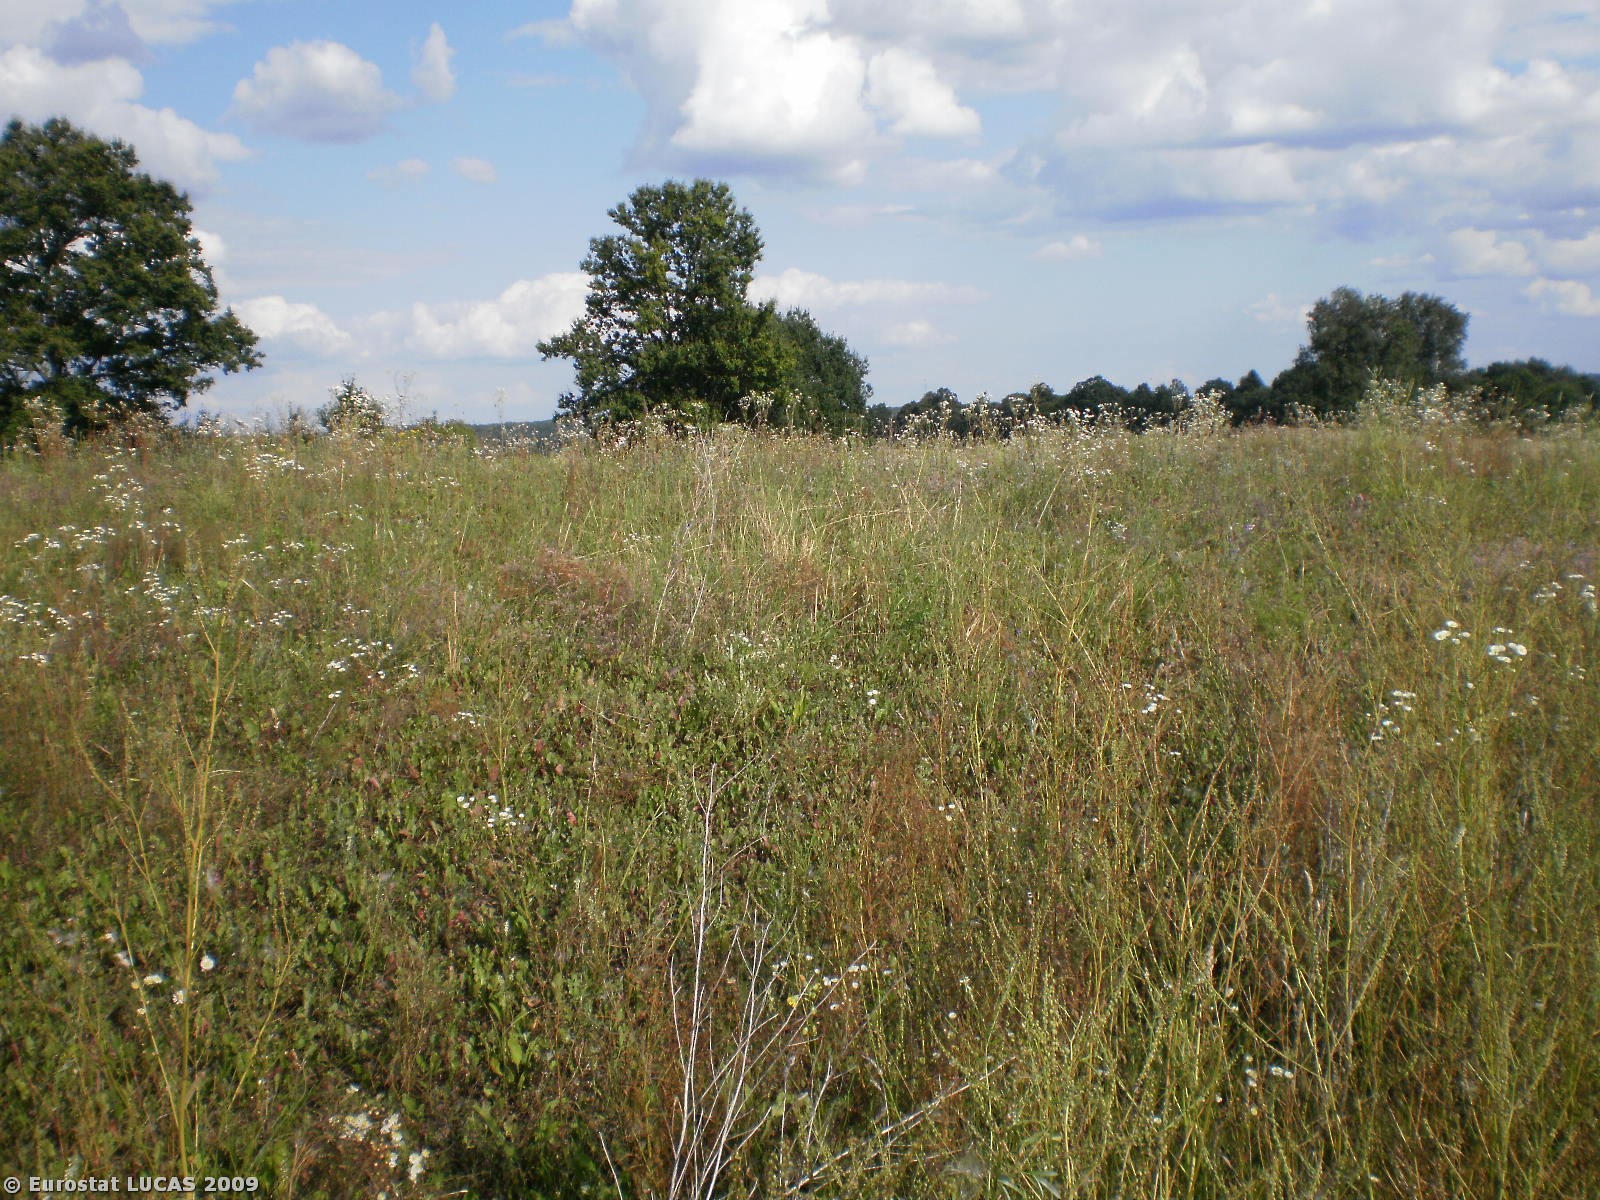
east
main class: Grassland
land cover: Grassland without tree/shrub cover
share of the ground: > 75 %
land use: Fallow land
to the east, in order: Grassland without tree/shrub cover; Abandoned hedges; Spontaneously vegetated surfaces; Tracks; Grassland without tree/shrub cover
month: August
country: PL
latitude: 53.8852
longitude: 21.1354
